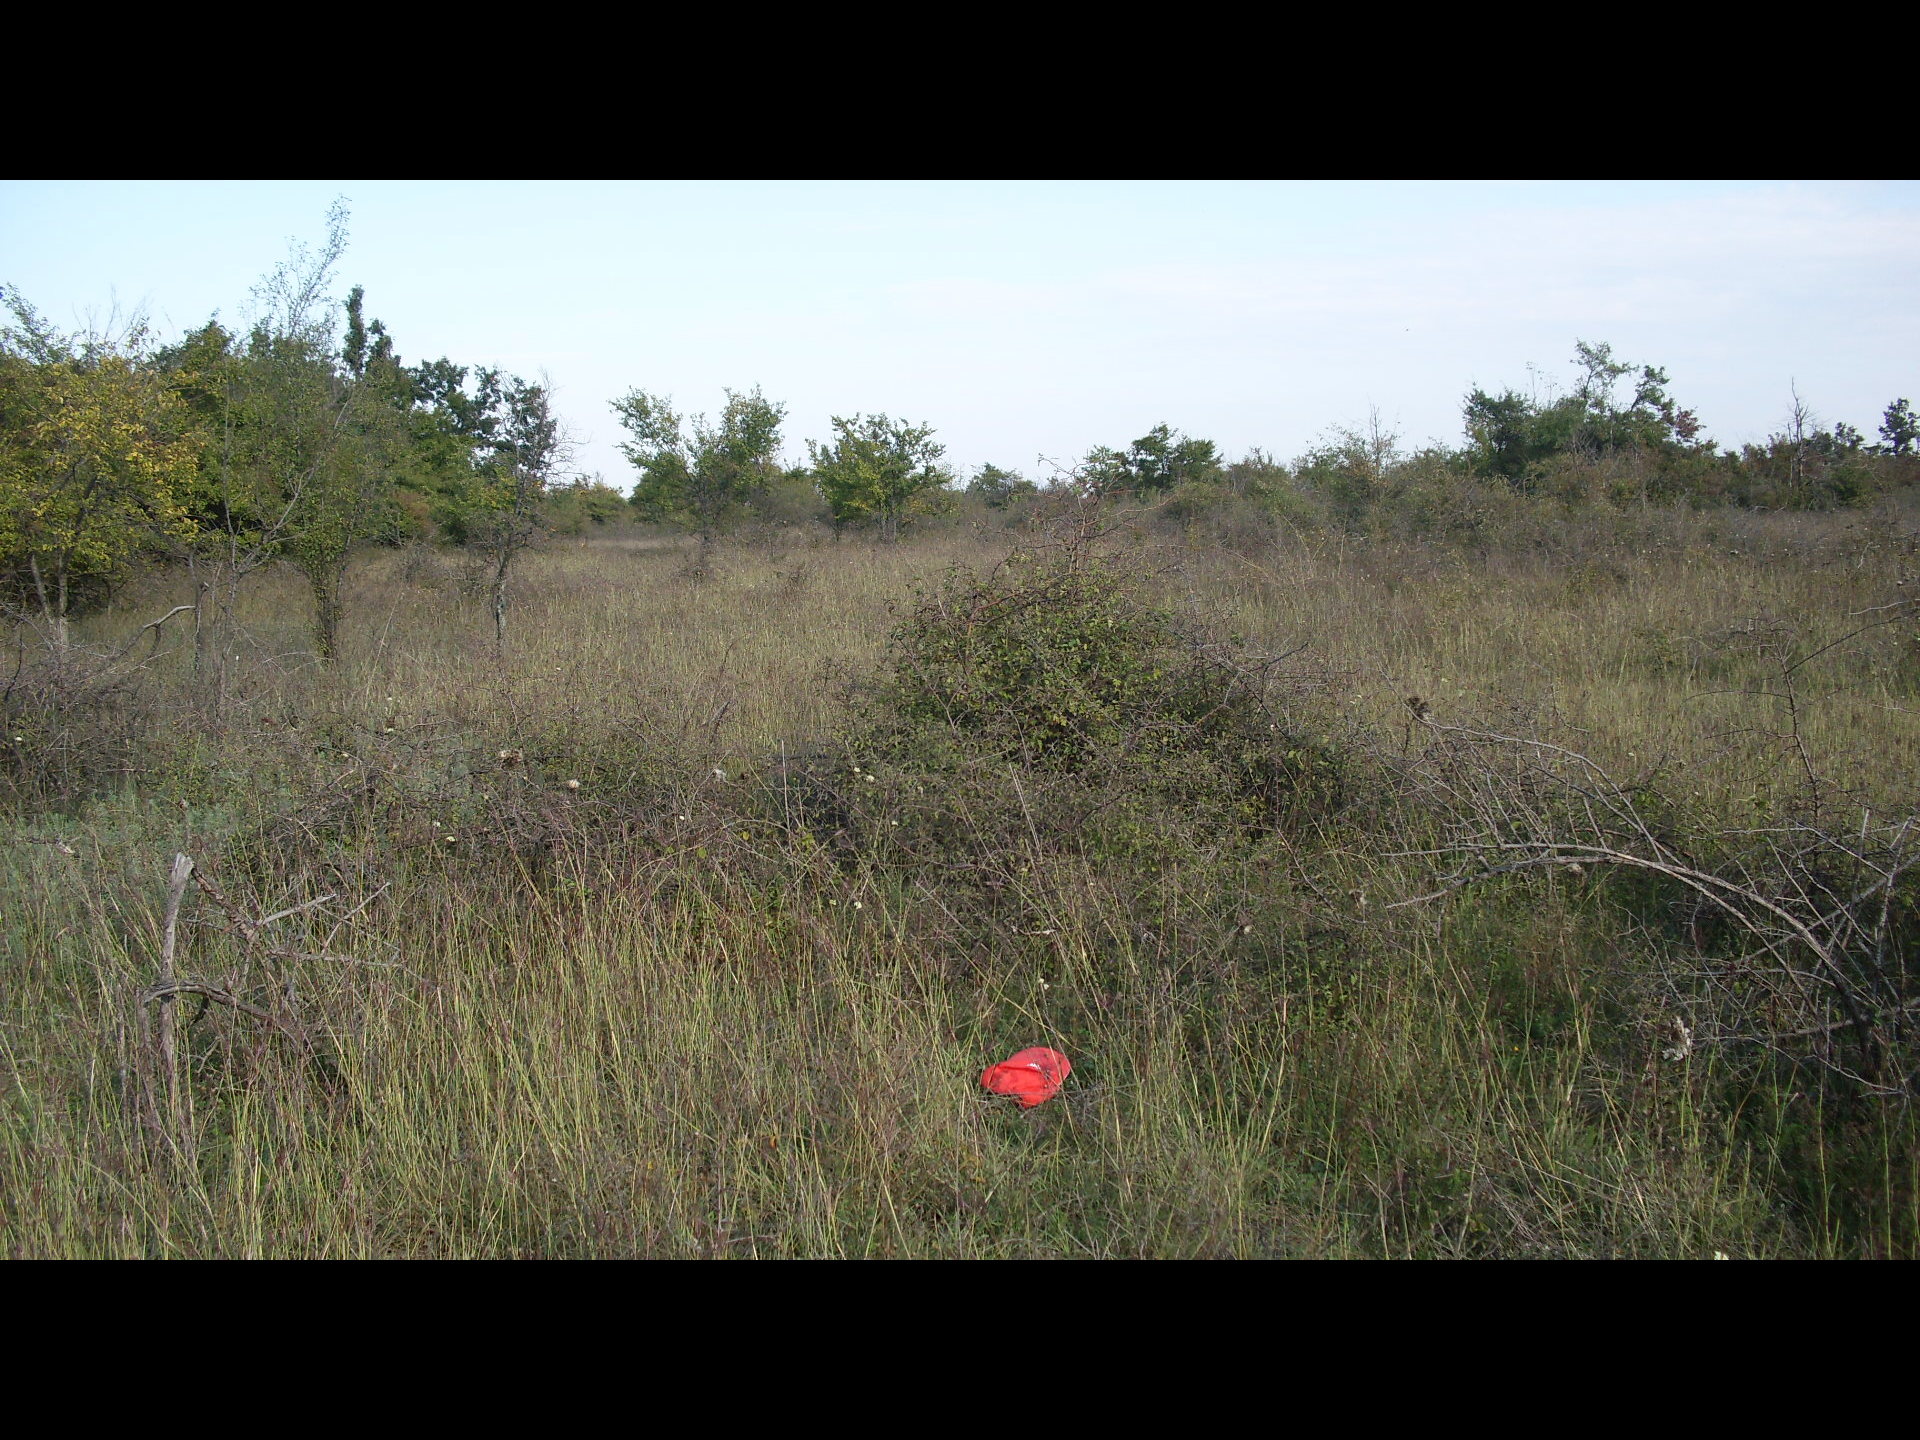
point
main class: Shrubland
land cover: Shrubland with sparse tree cover
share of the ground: > 75 %
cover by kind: shrubs 75 %, herbaceous plants 20 %, broadleaved forest trees 5 %
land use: Semi-natural and natural areas not in use
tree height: < 5 m
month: October
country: BG
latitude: 43.8428
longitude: 22.3827
